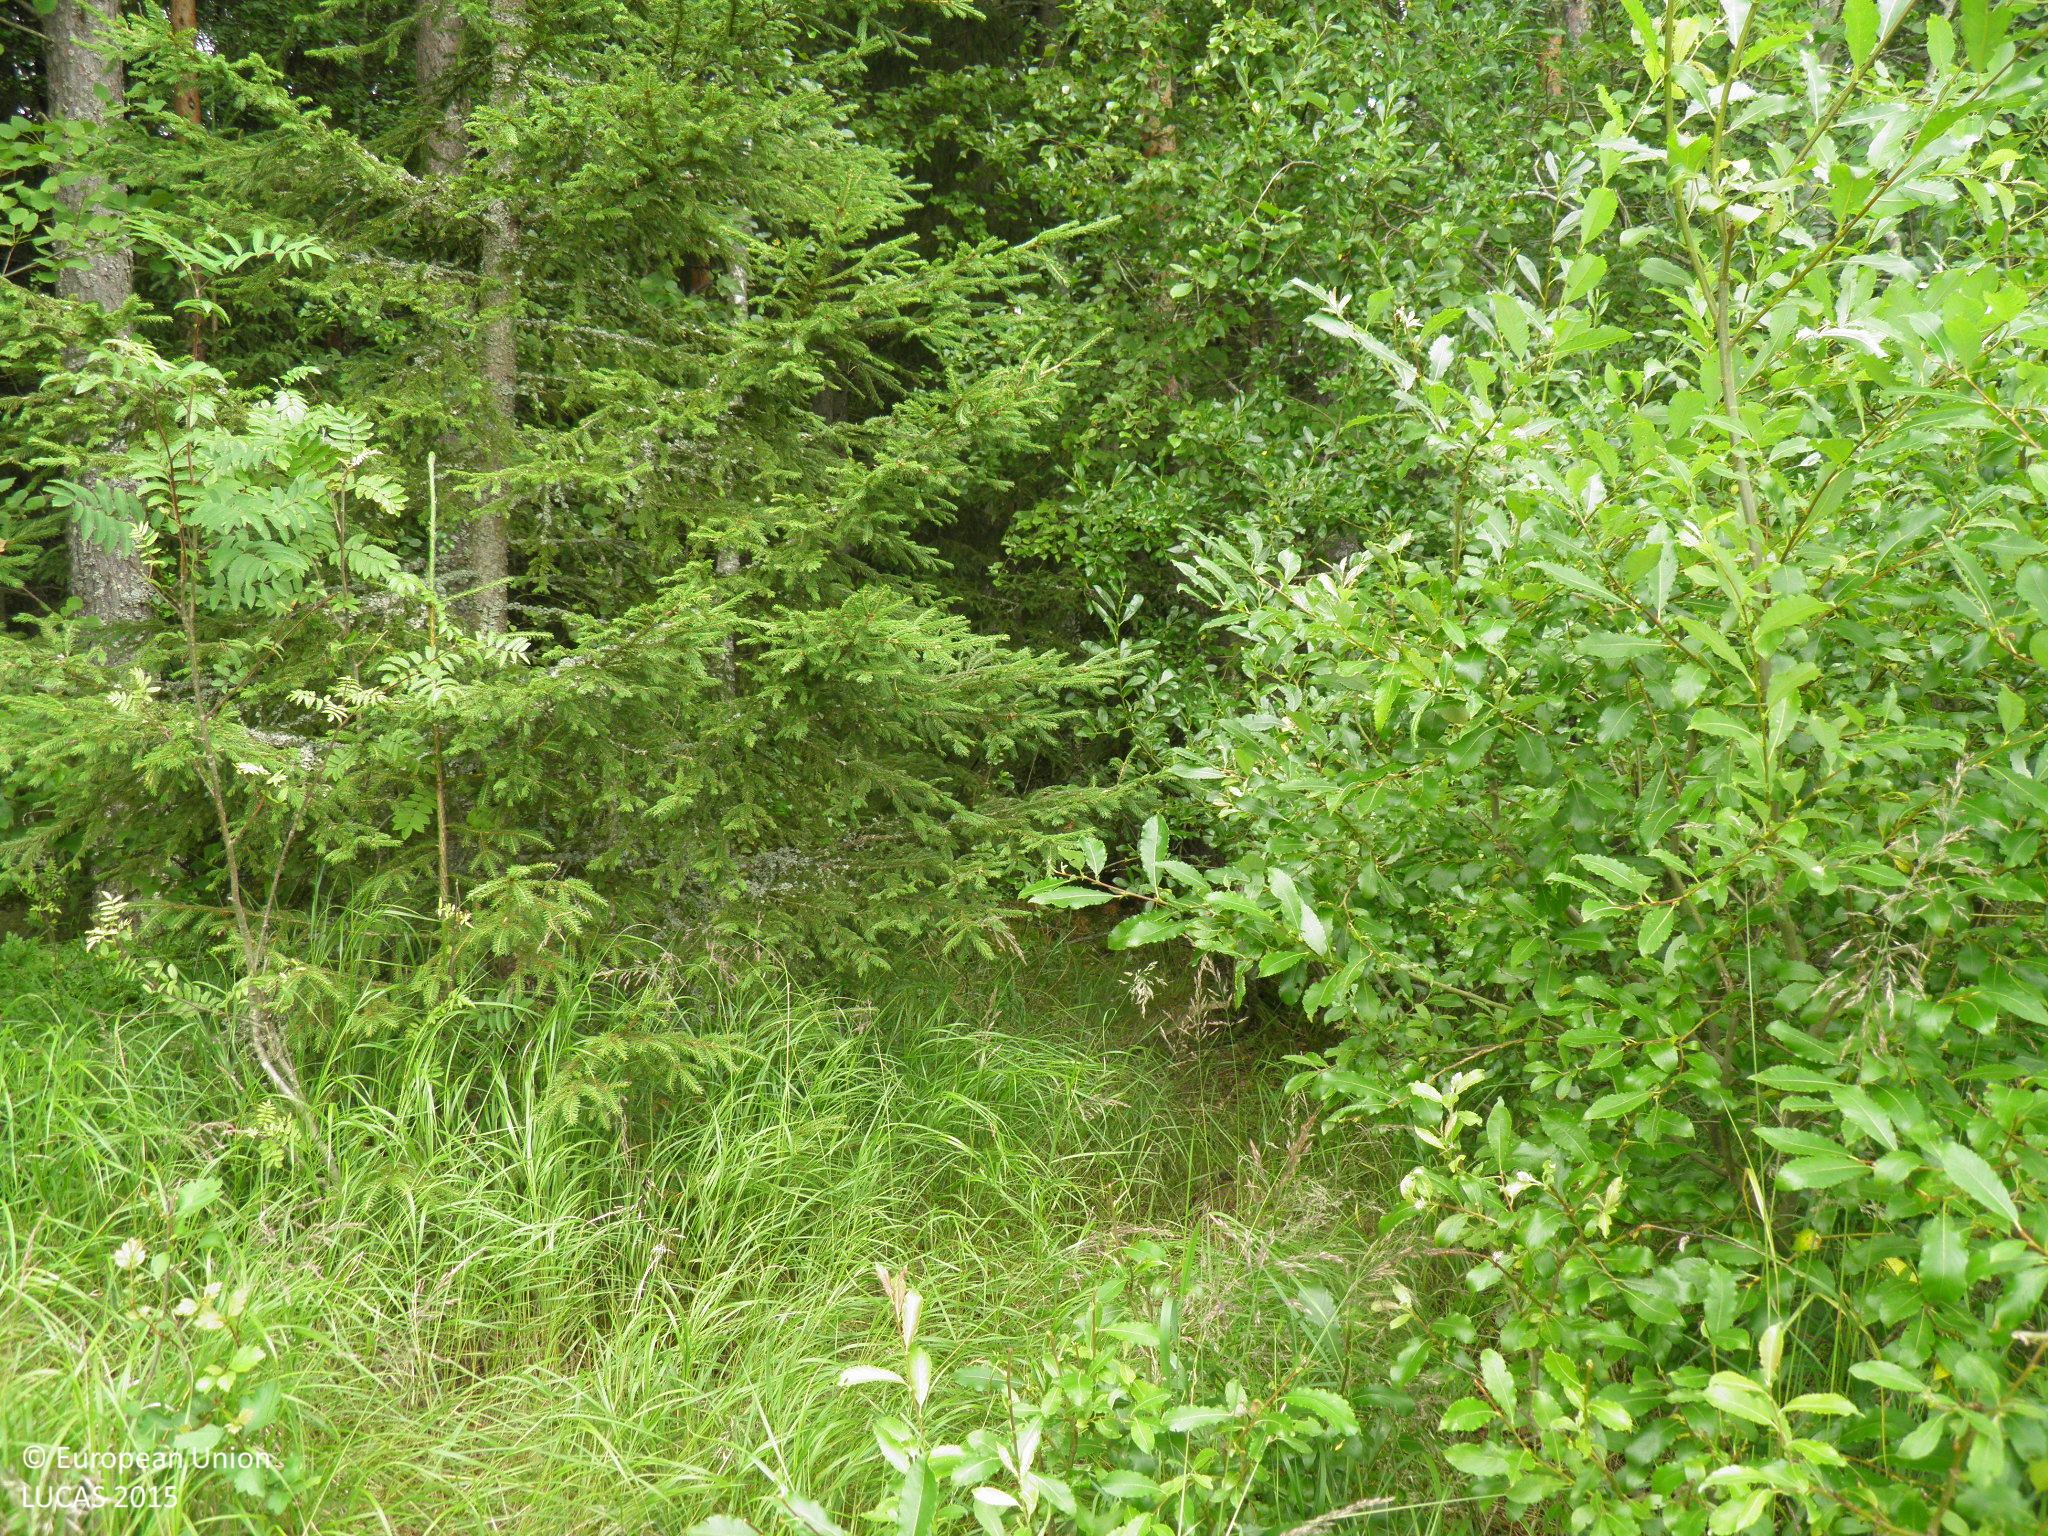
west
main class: Cropland
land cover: Common wheat
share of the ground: > 75 %
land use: Agriculture (excluding fallow land and kitchen gardens)
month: July
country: FI
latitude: 60.8433
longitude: 22.9366
